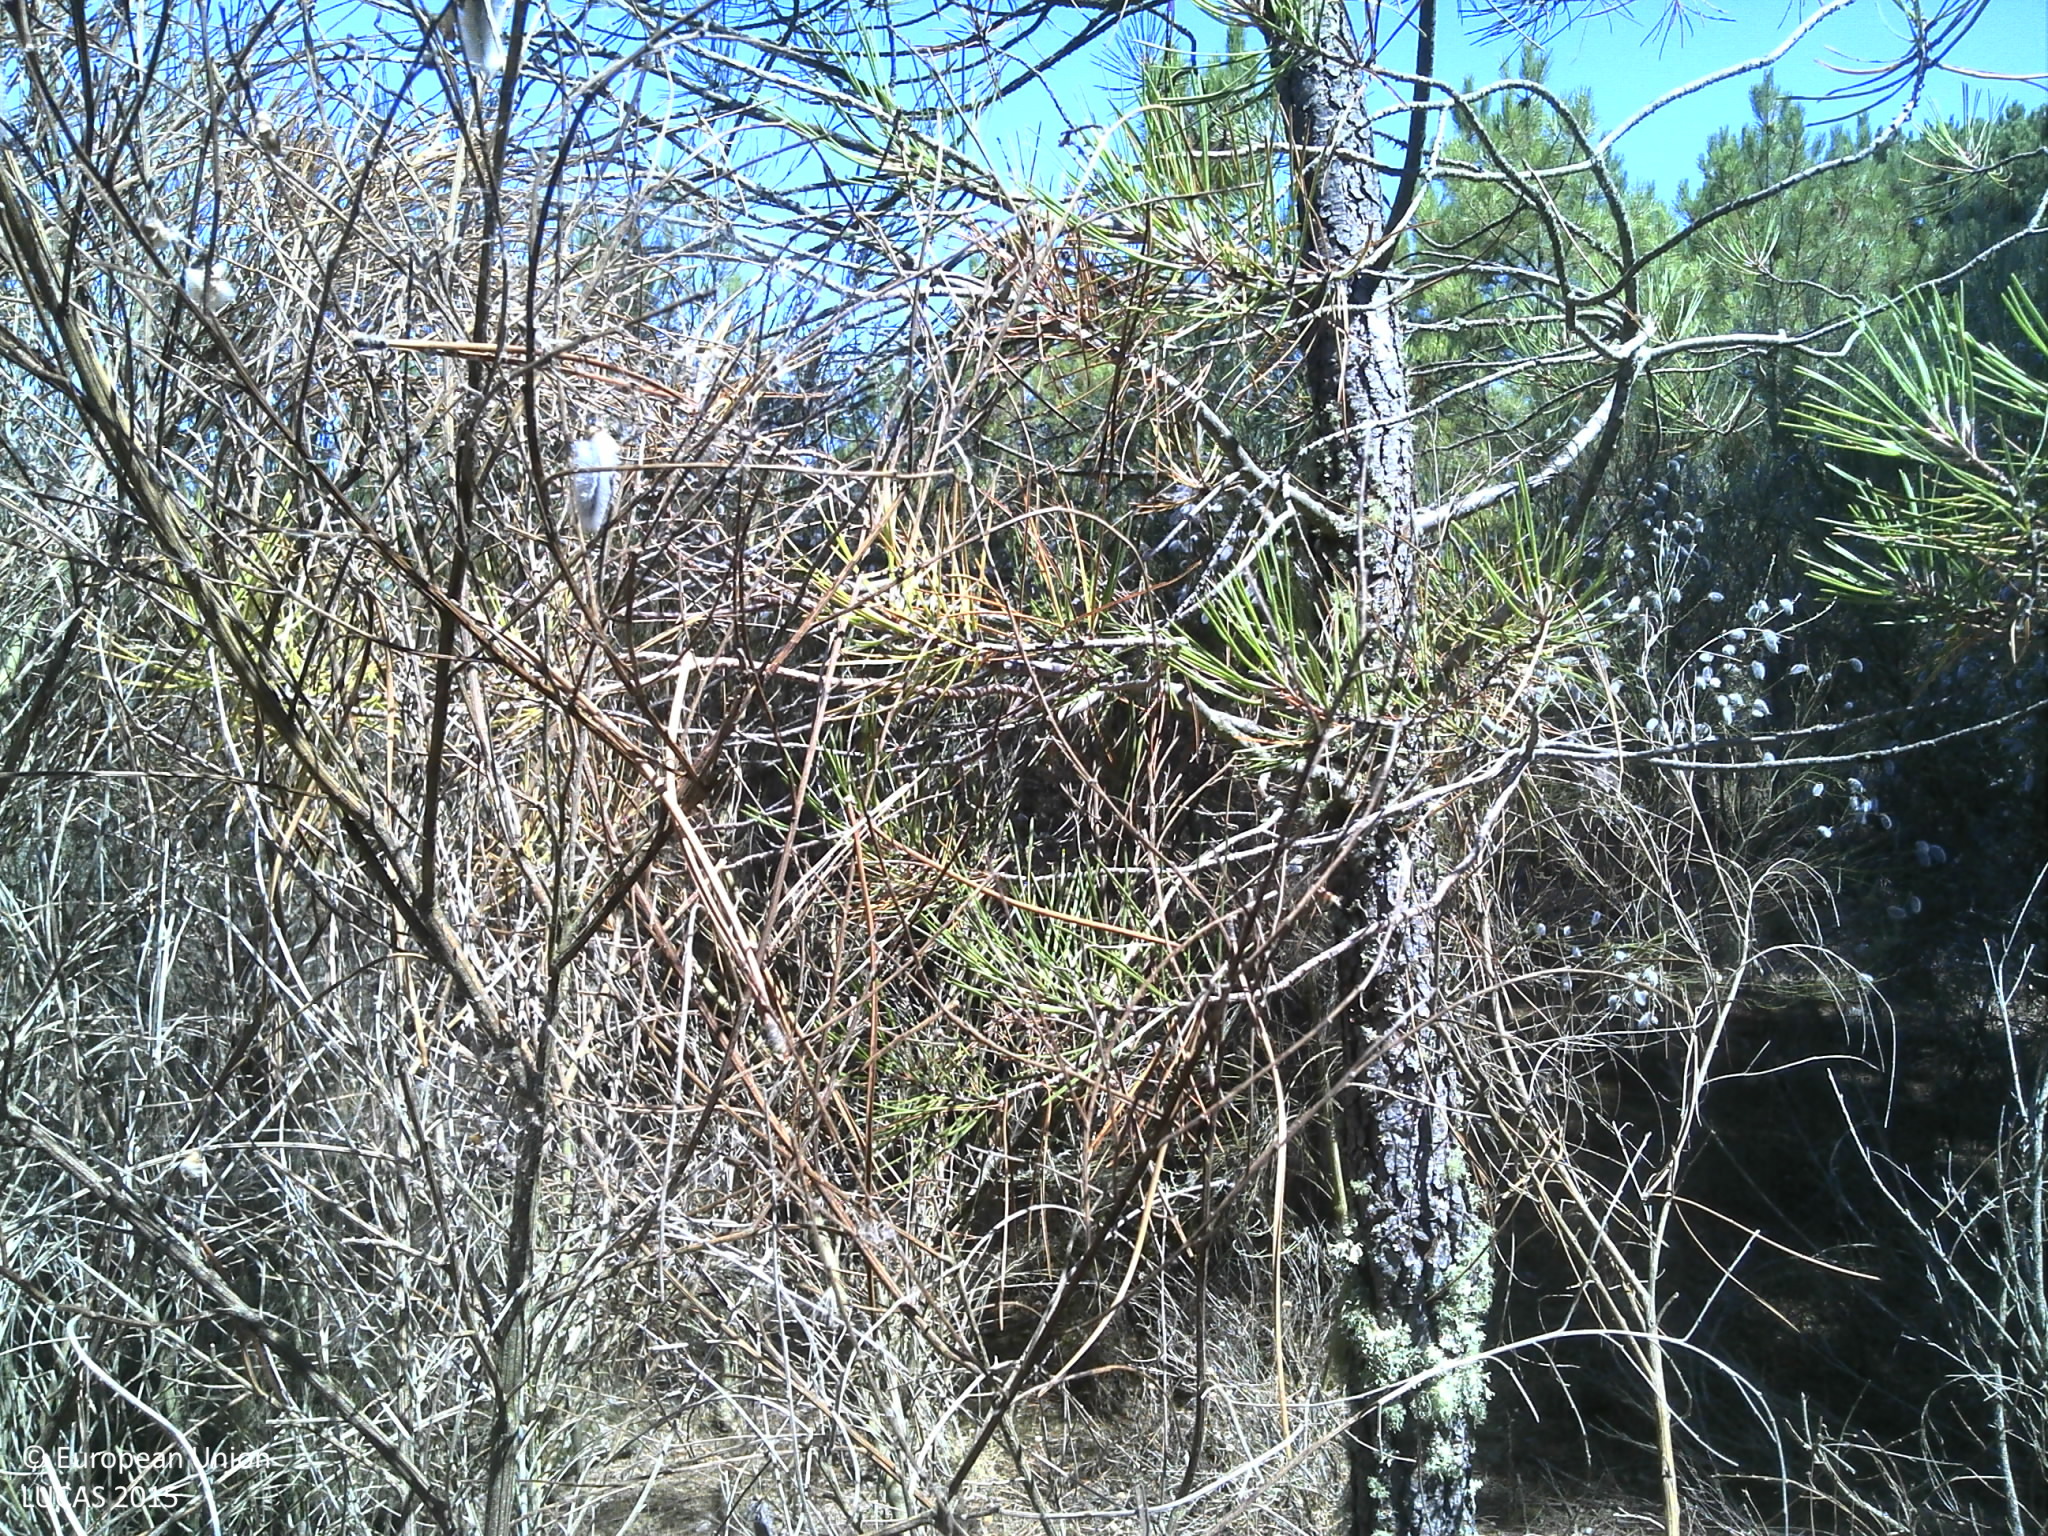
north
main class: Woodland
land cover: Pine dominated coniferous woodland
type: coniferous forest of the mediterranean region
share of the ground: < 10 %
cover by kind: unconsolidated bare surface 50 %, shrubs 30 %, coniferous forest trees 20 %
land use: Forestry
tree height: > 5 m
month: July
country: PT
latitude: 41.2460
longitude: -7.2894
